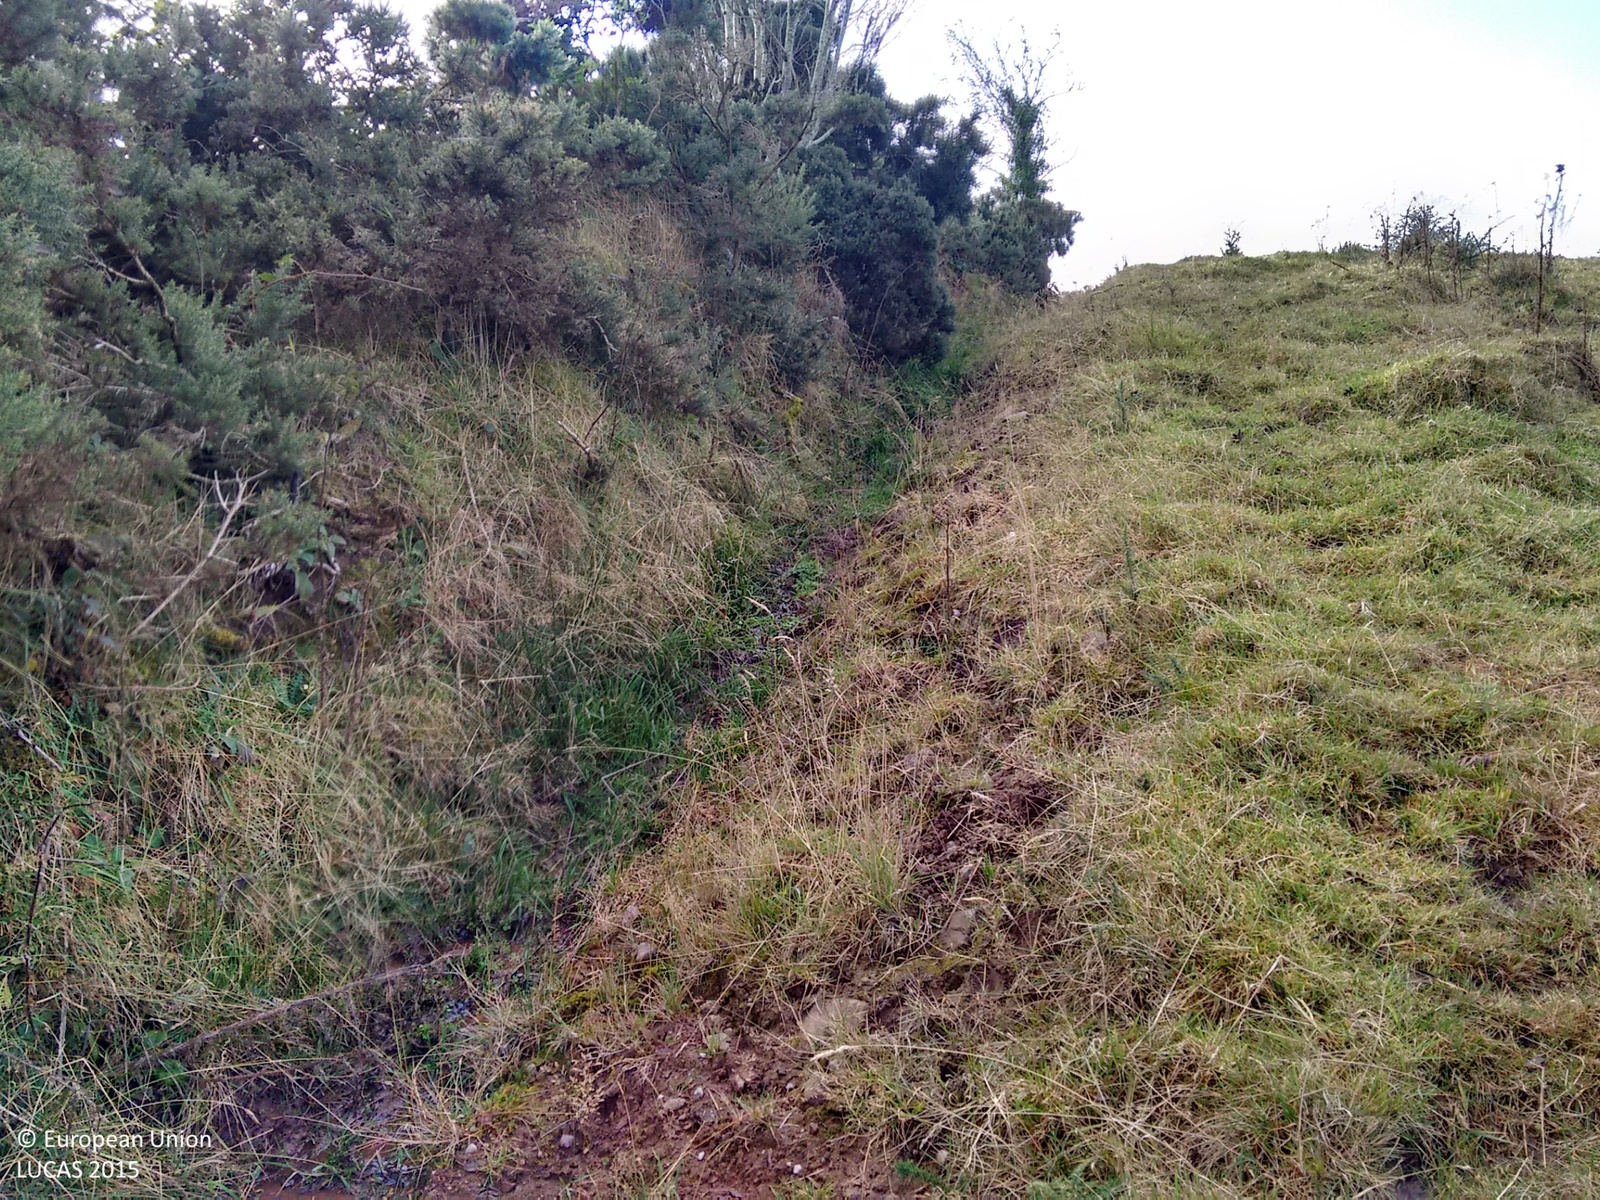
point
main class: Grassland
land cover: Grassland without tree/shrub cover
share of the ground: > 75 %
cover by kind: herbaceous plants 100 %
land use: Agriculture (excluding fallow land and kitchen gardens)
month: October
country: GB
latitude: 54.4526
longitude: -7.3800
